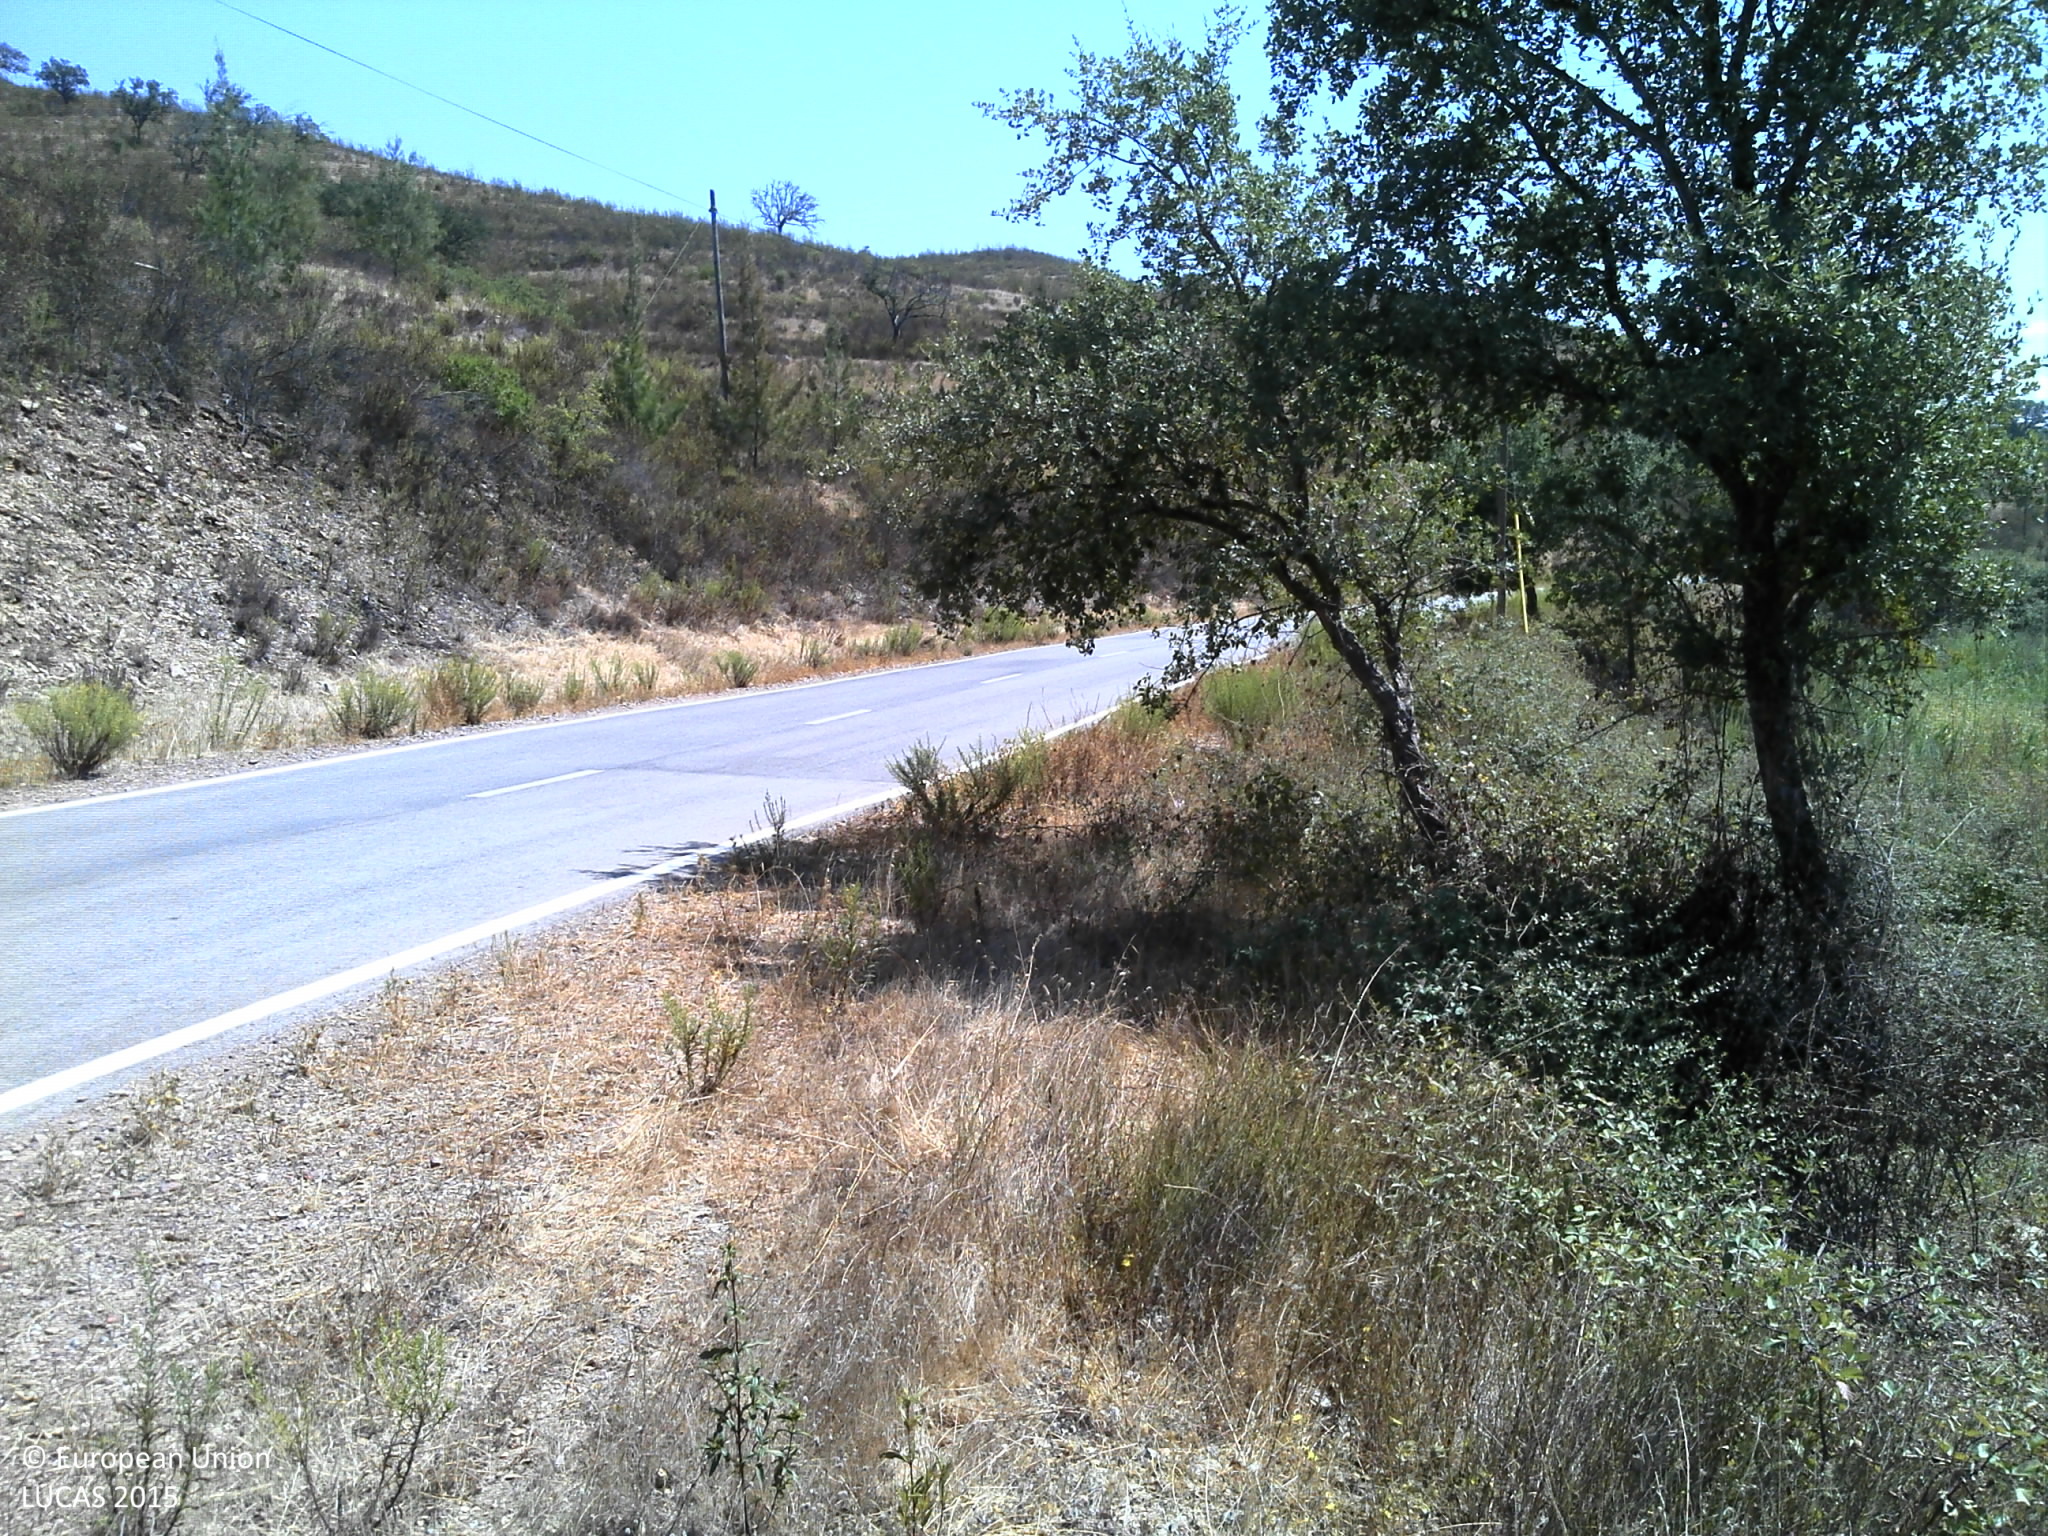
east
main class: Shrubland
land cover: Shrubland with sparse tree cover
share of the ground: 25 - 50 %
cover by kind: shrubs 40 %, herbaceous plants 40 %, unconsolidated bare surface 15 %, broadleaved forest trees 5 %
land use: Forestry
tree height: < 5 m
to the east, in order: Shrubland with sparse tree cover; Paved roads, cycling and walking lanes; Grass margins; Ditches and canals; Shruby margins; Other coniferous woodland; Electric lines; Pine dominated coniferous woodland; Rivers and streams; Broadleaved woodland; Other structural elements; Broadleaved woodland; Shrubland with sparse tree cover; Tracks; Shrubland with sparse tree cover
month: September
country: PT
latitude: 37.4985
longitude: -8.2719
